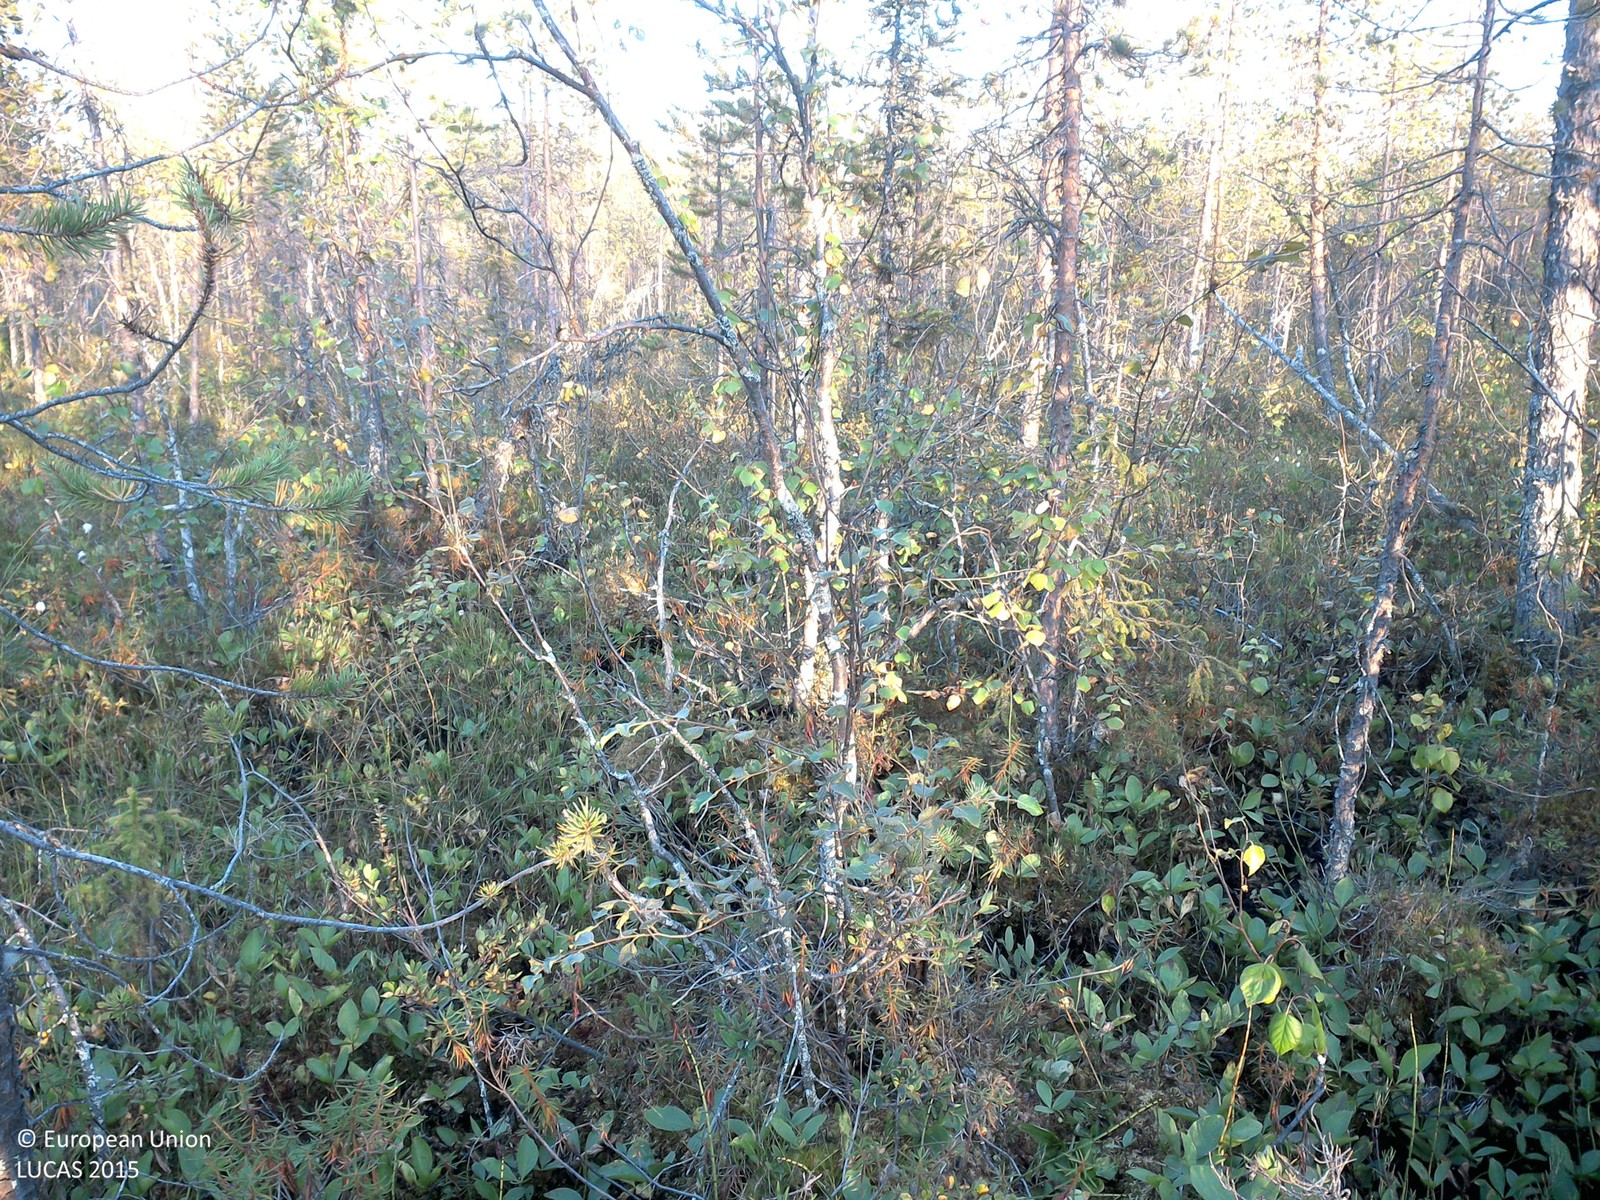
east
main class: Woodland
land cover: Pine dominated mixed woodland
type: boreal forest
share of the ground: 25 - 50 %
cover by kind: lichens and mosses 30 %, herbaceous plants 25 %, coniferous forest trees 20 %, broadleaved forest trees 15 %, shrubs 10 %
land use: Semi-natural and natural areas not in use
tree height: > 5 m
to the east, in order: Pine dominated mixed woodland; Pine dominated coniferous woodland; Pine dominated mixed woodland; Other mixed woodland; Spruce dominated mixed woodland
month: August
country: SE
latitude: 67.1668
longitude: 22.5487
